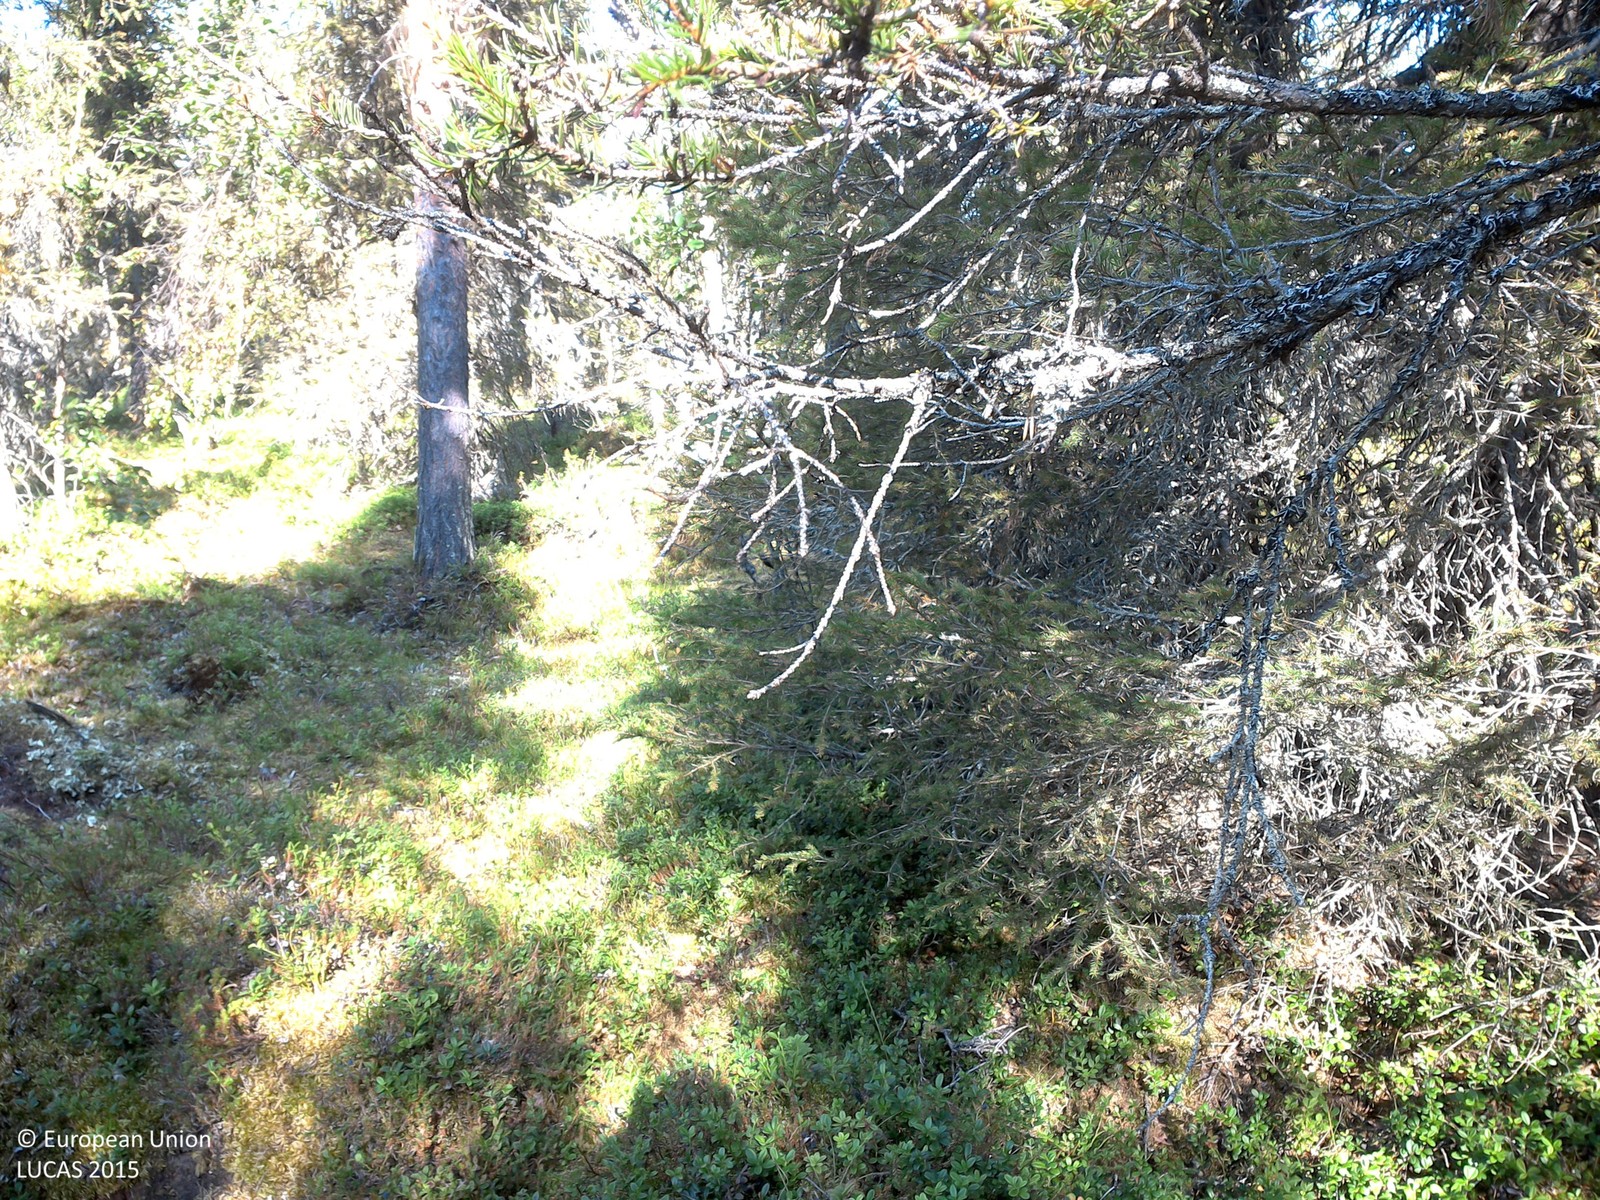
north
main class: Woodland
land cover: Spruce dominated mixed woodland
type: boreal forest
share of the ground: 25 - 50 %
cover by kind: shrubs 50 %, coniferous forest trees 25 %, lichens and mosses 15 %, broadleaved forest trees 10 %
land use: Forestry
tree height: > 5 m
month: August
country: SE
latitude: 67.0953
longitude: 22.0009
